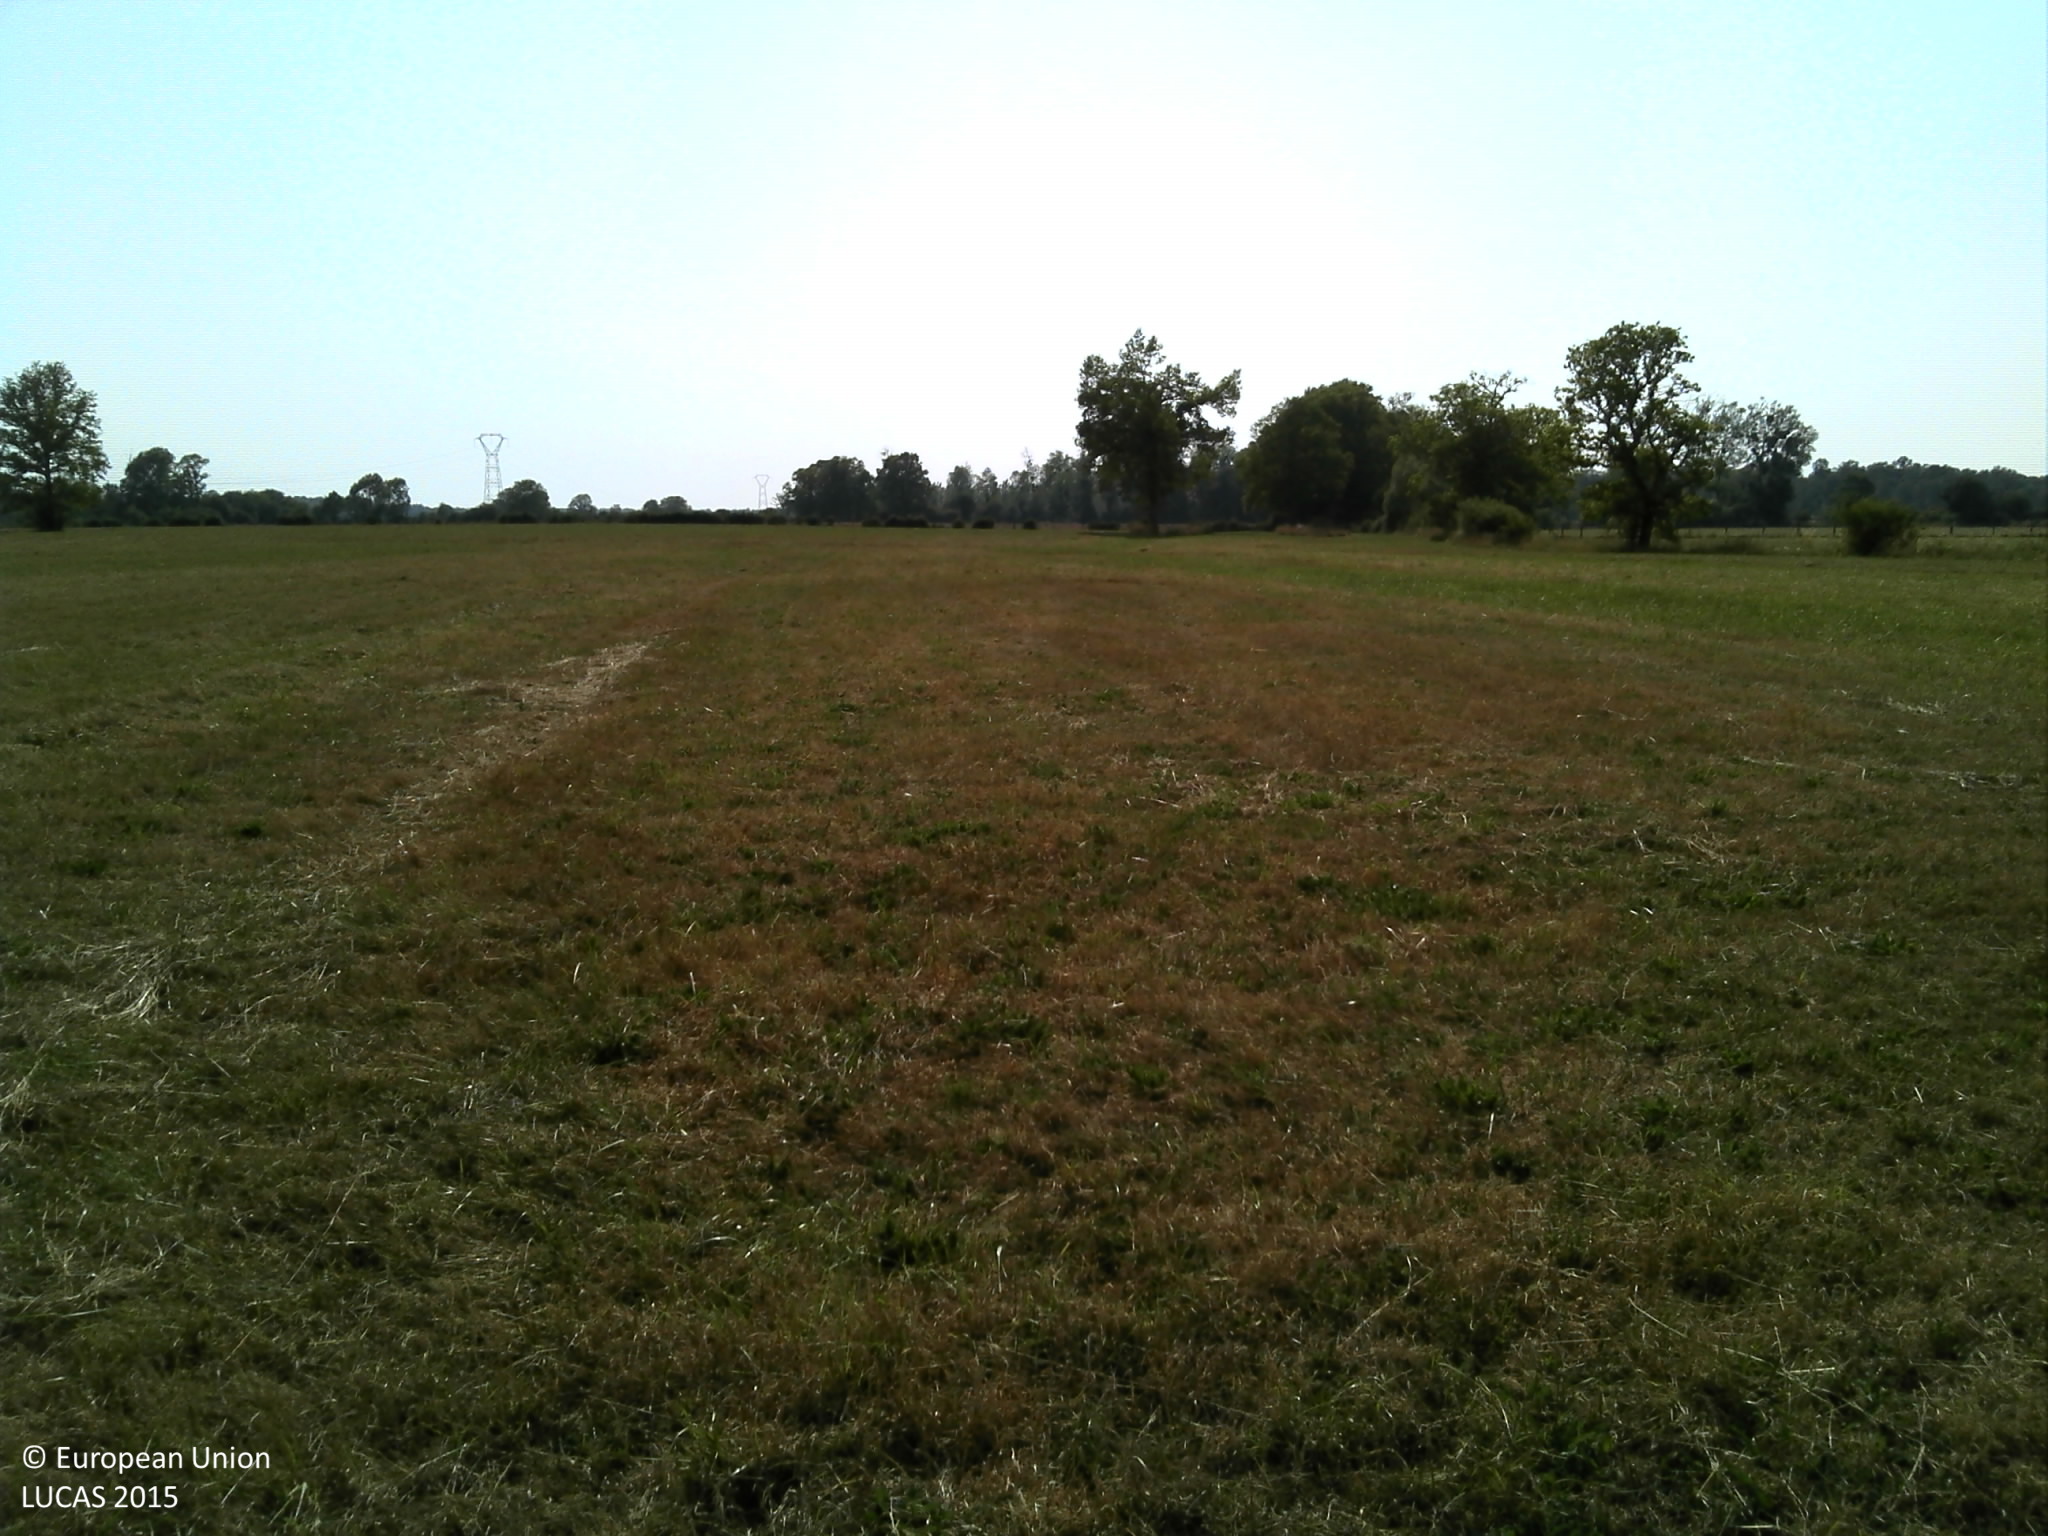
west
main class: Grassland
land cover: Grassland without tree/shrub cover
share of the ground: > 75 %
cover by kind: herbaceous plants 100 %
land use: Agriculture (excluding fallow land and kitchen gardens)
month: July
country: FR
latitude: 48.8224
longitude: 4.8082
